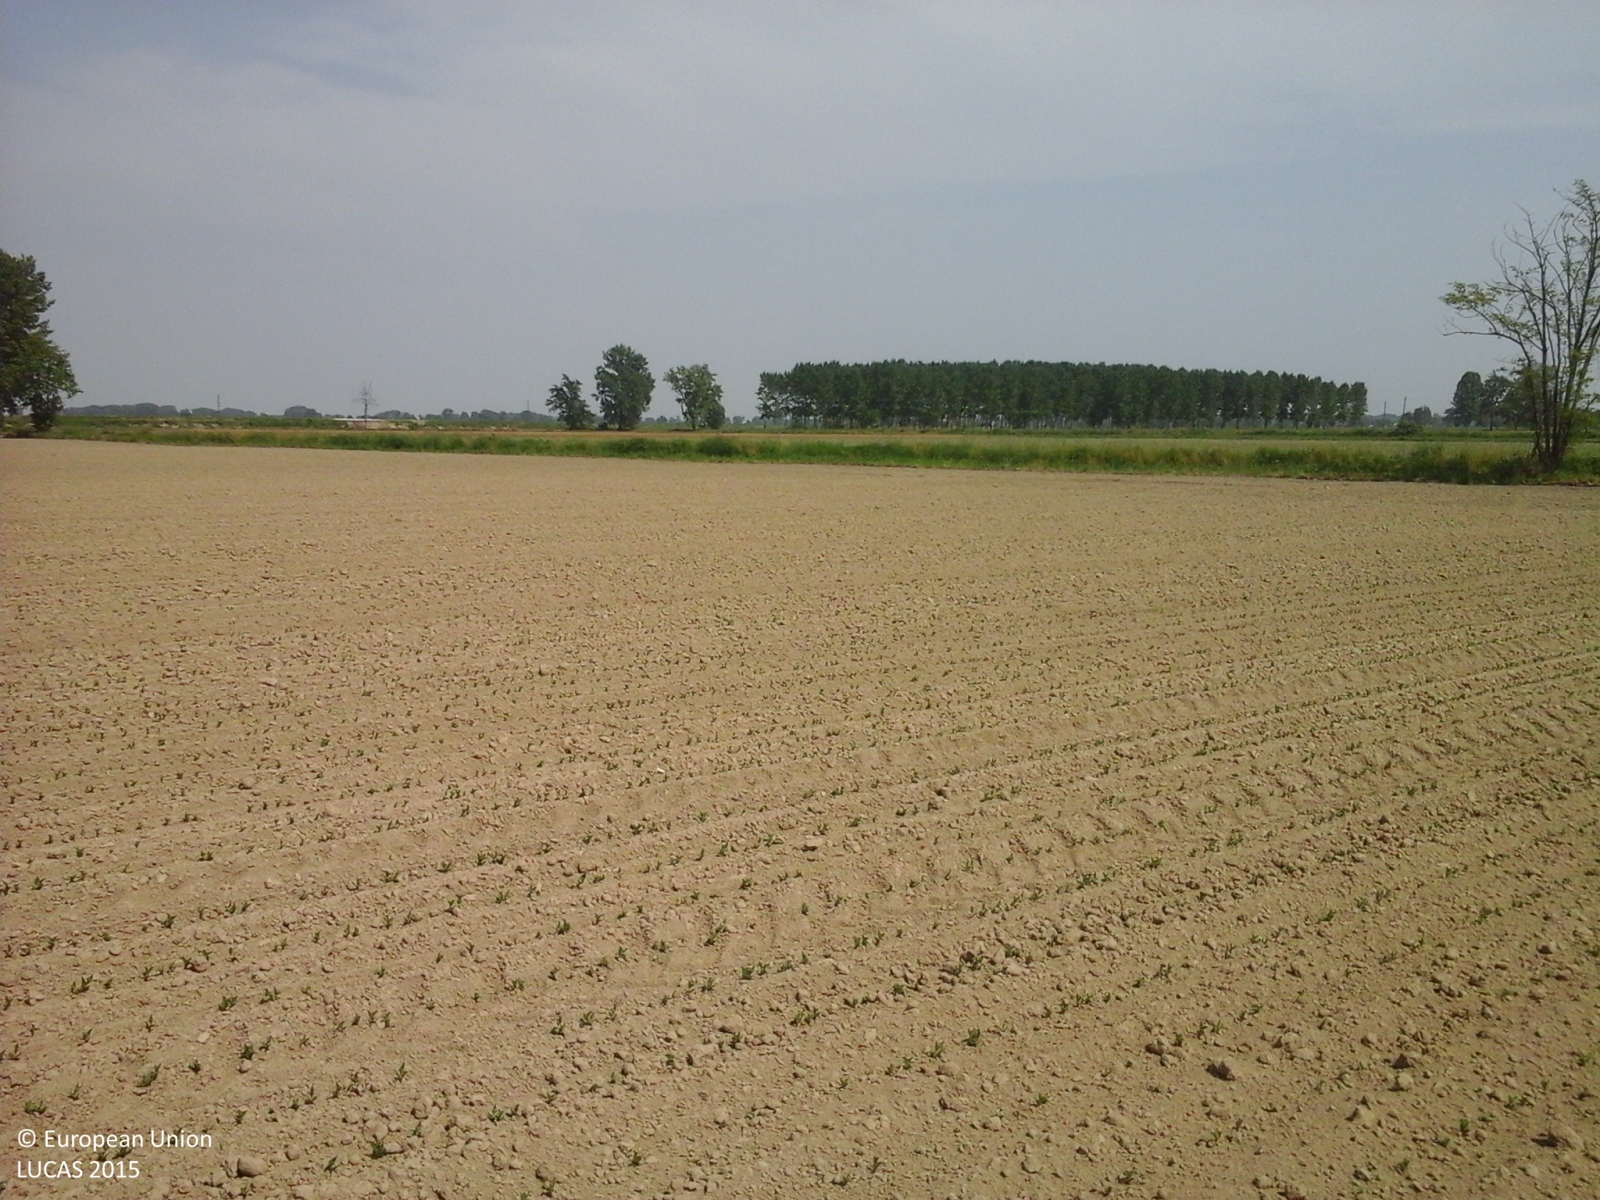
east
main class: Cropland
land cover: Soya
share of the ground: < 10 %
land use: Agriculture (excluding fallow land and kitchen gardens)
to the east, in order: Soya; Grass margins; Ditches and canals; Grassland without tree/shrub cover; Maize
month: May
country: IT
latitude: 45.2142
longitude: 9.3772
